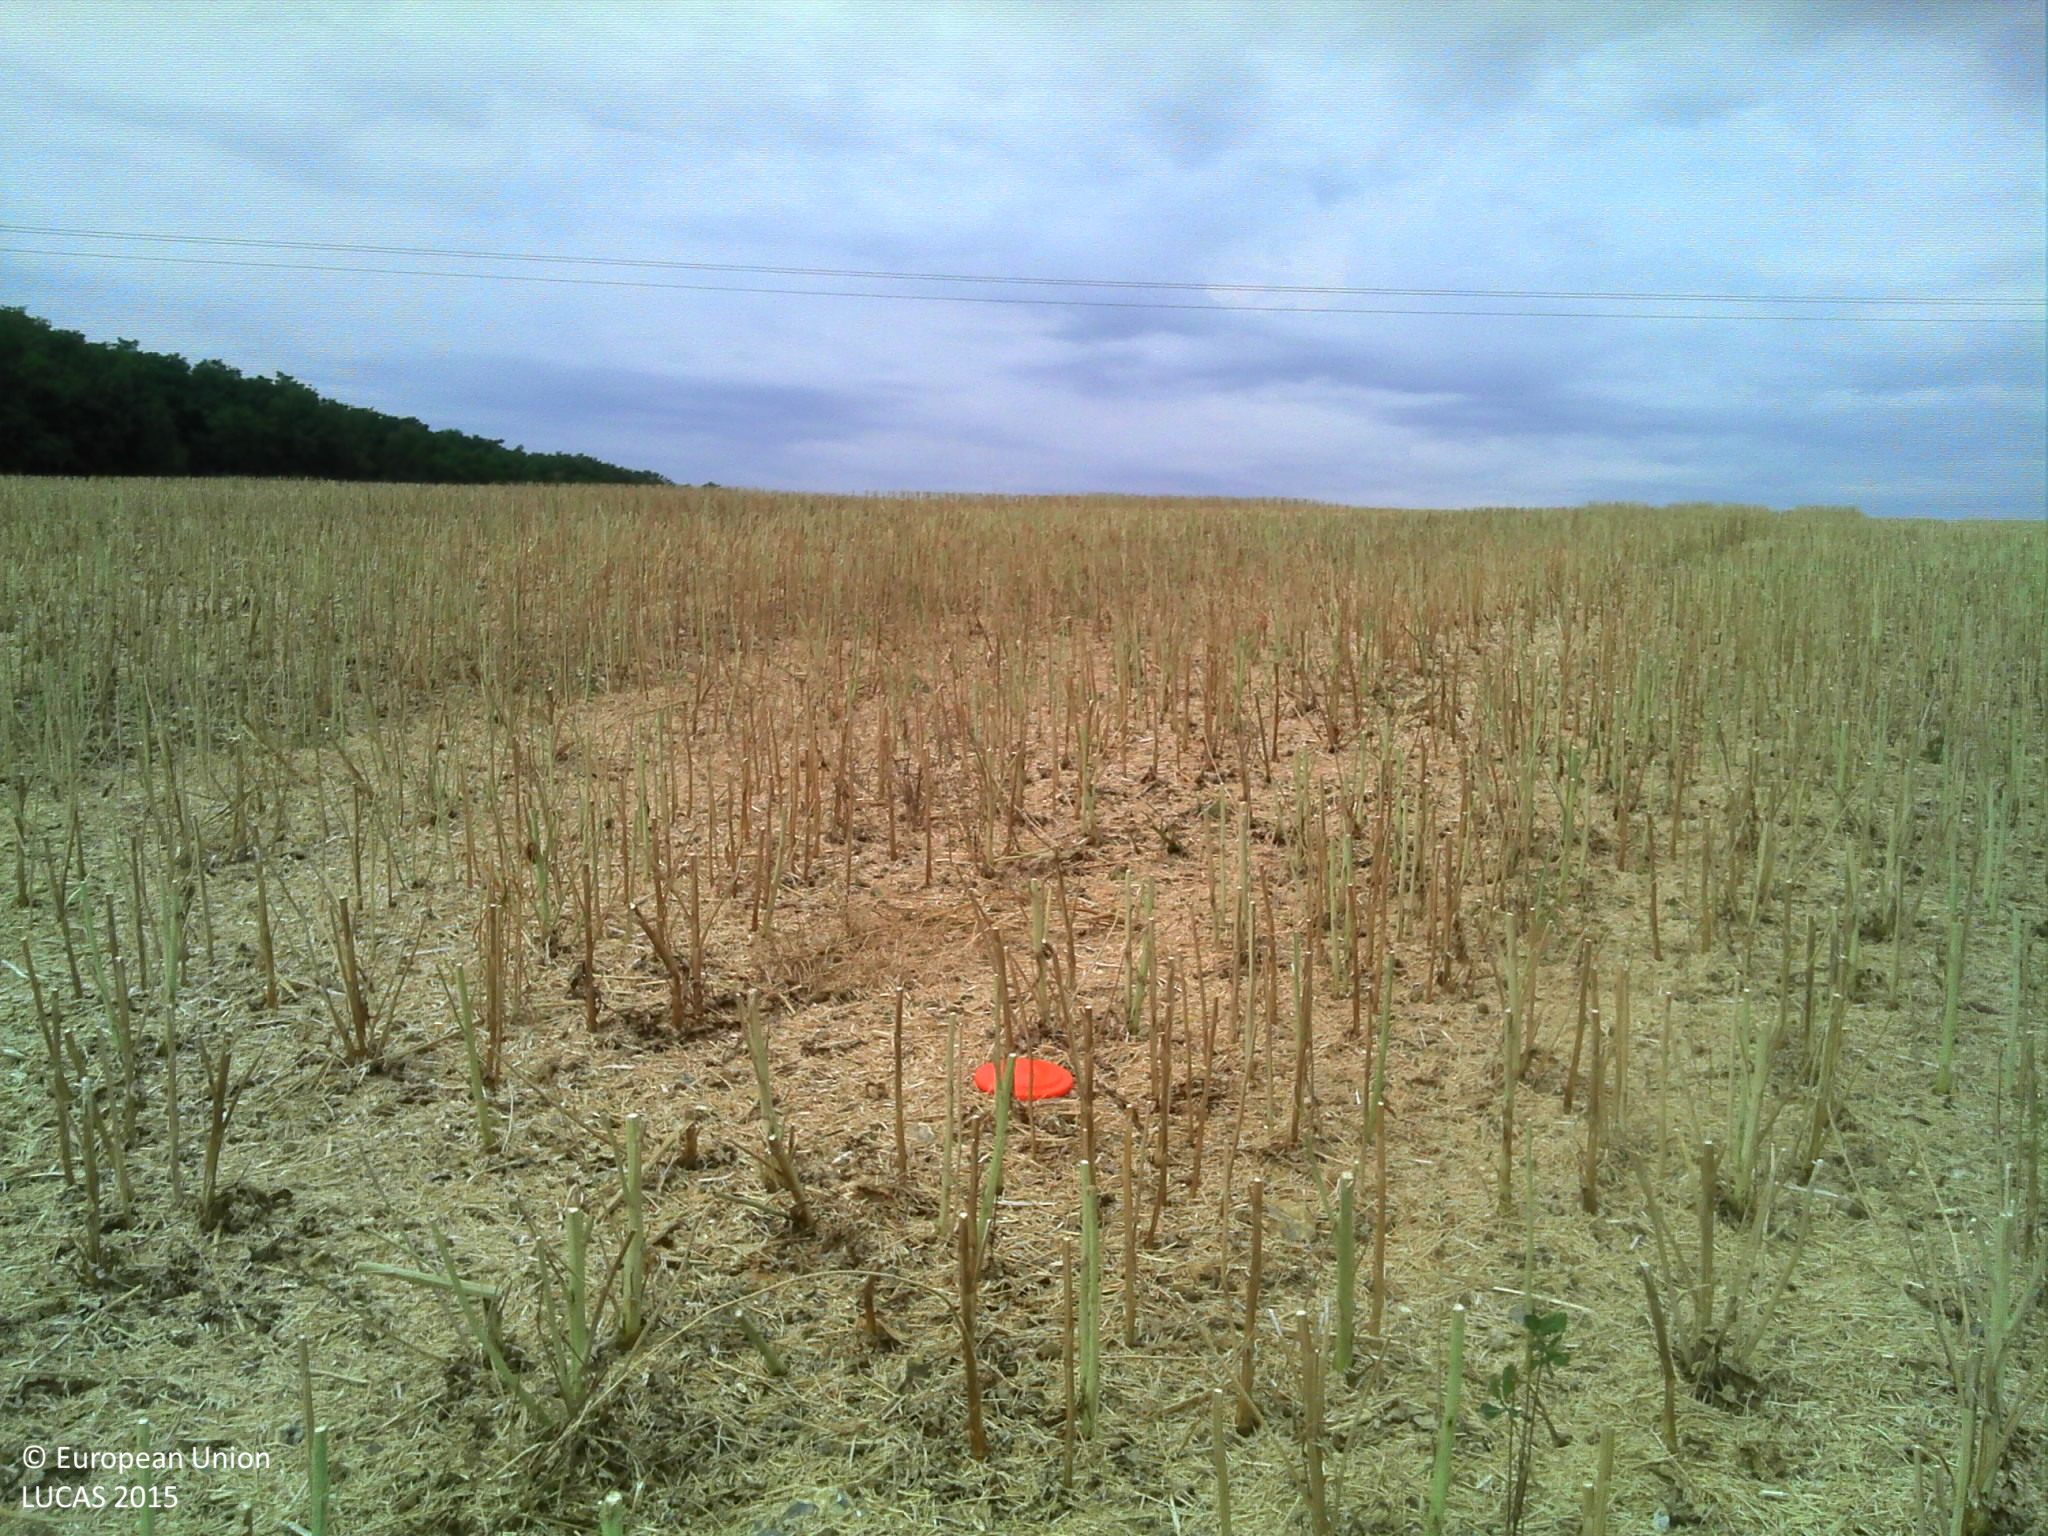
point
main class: Cropland
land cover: Rape and turnip rape
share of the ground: > 75 %
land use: Agriculture (excluding fallow land and kitchen gardens)
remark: Harvested field
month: July
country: FR
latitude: 48.1223
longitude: 3.5060
